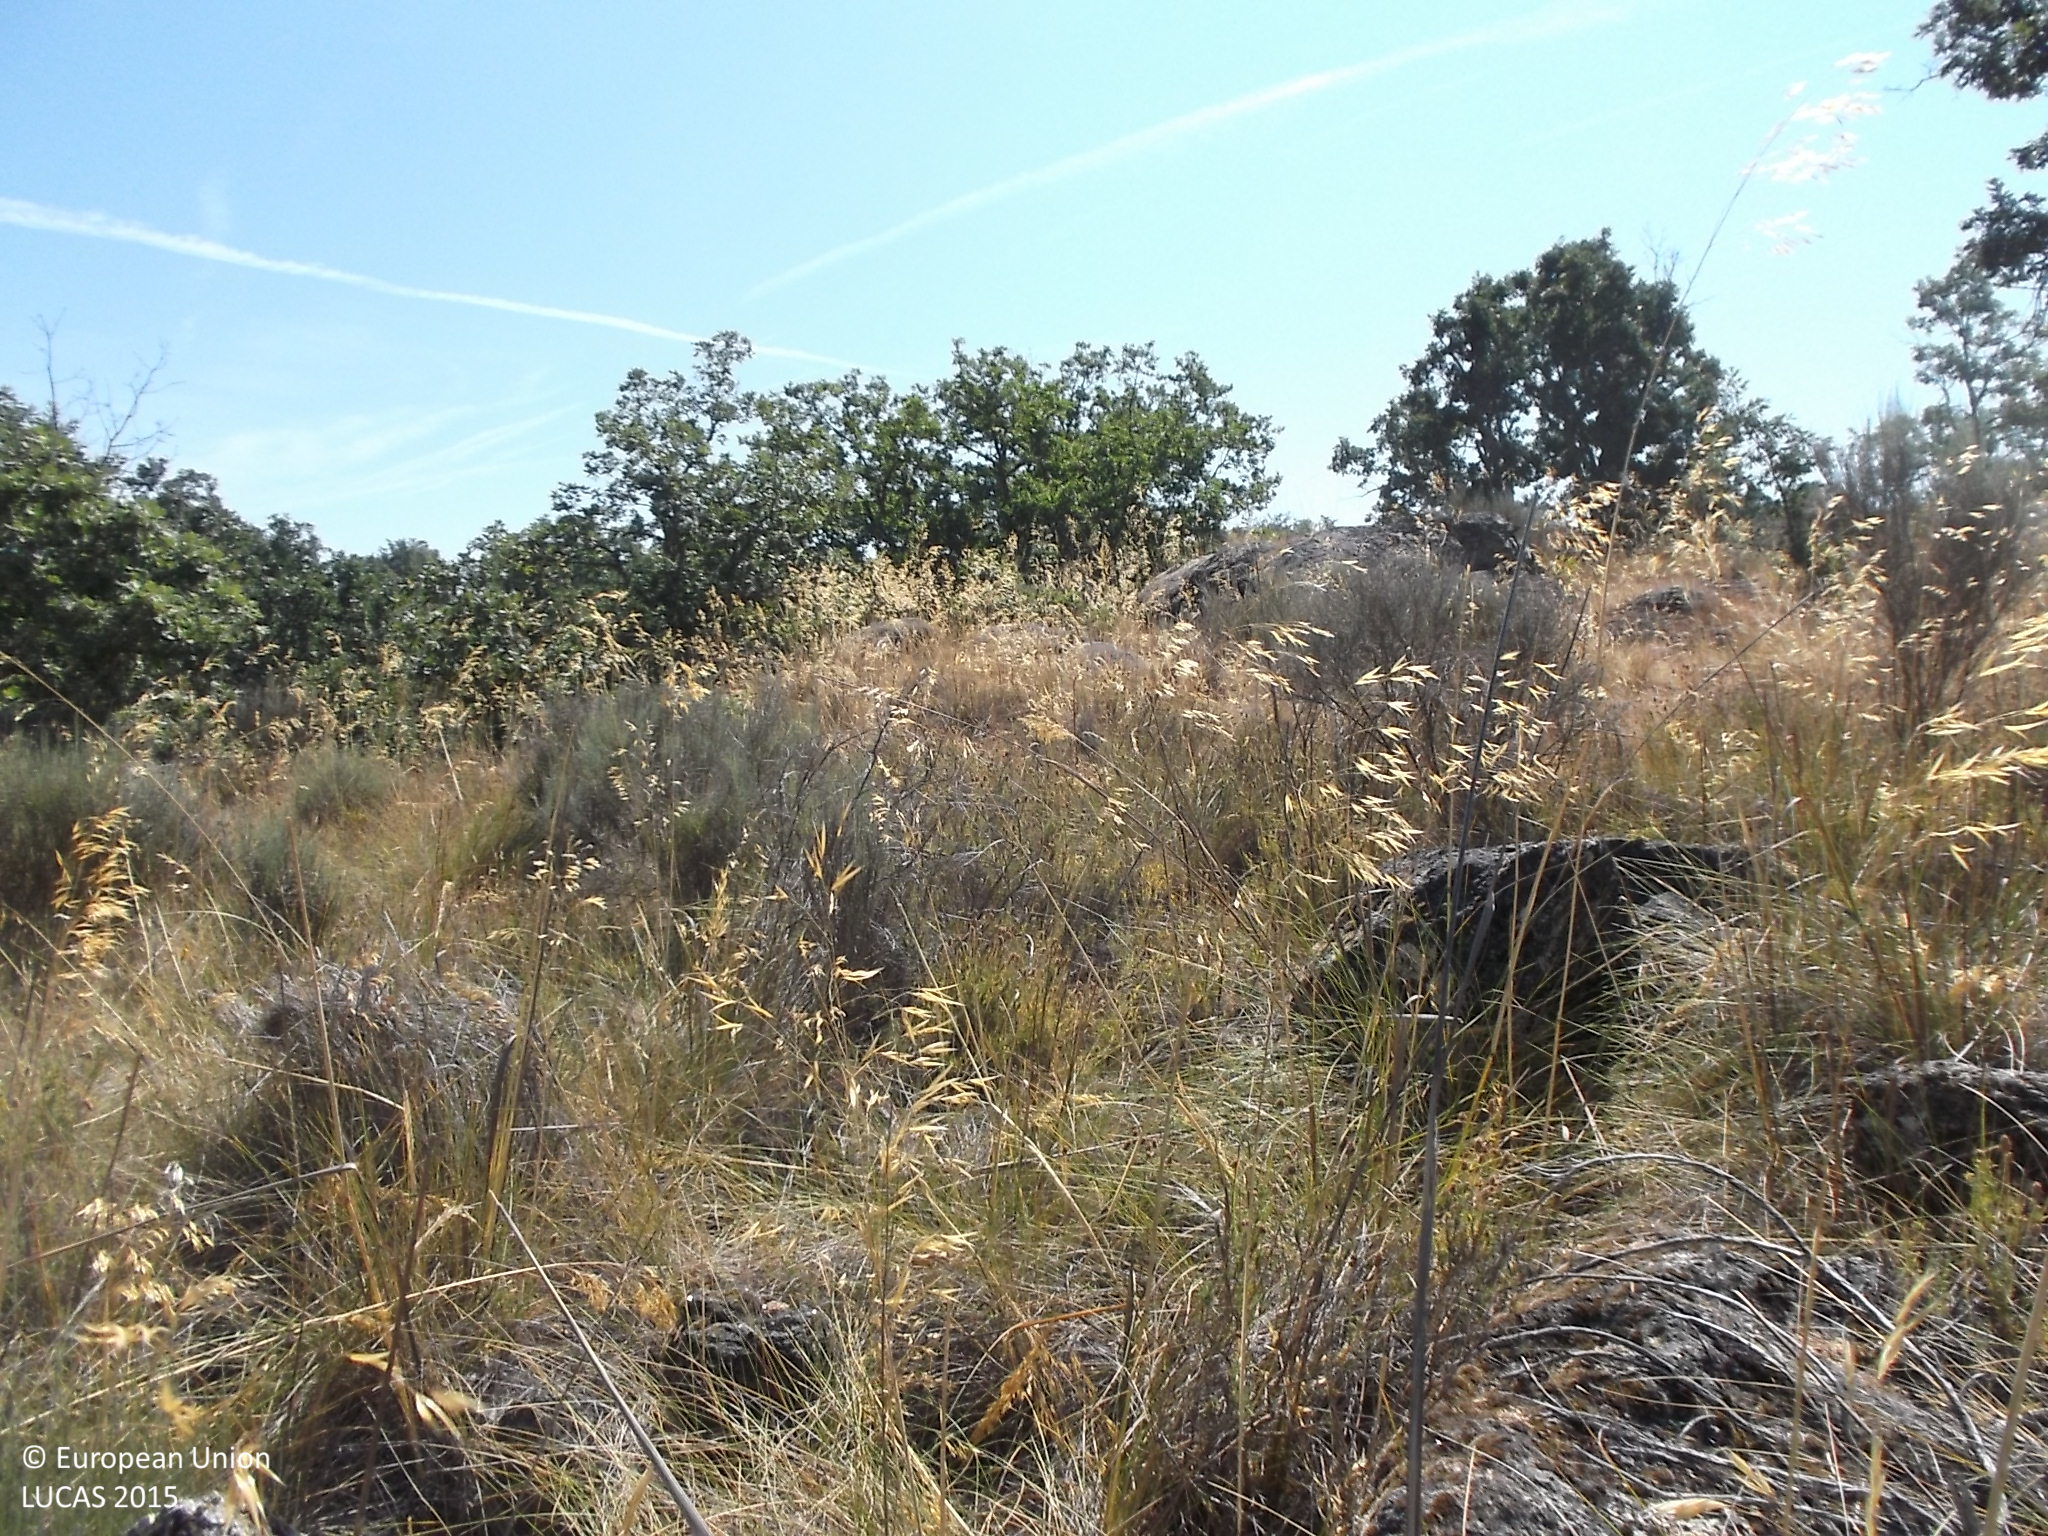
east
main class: Shrubland
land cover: Shrubland with sparse tree cover
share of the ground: > 75 %
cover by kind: shrubs 80 %, herbaceous plants 15 %, broadleaved forest trees 5 %
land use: Agriculture (excluding fallow land and kitchen gardens)
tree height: < 5 m
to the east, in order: Shrubland with sparse tree cover; Dry stone walls; Broadleaved woodland; Fences; Grassland with sparse tree/shrub cover
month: July
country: ES
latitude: 41.2203
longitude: -6.4756
